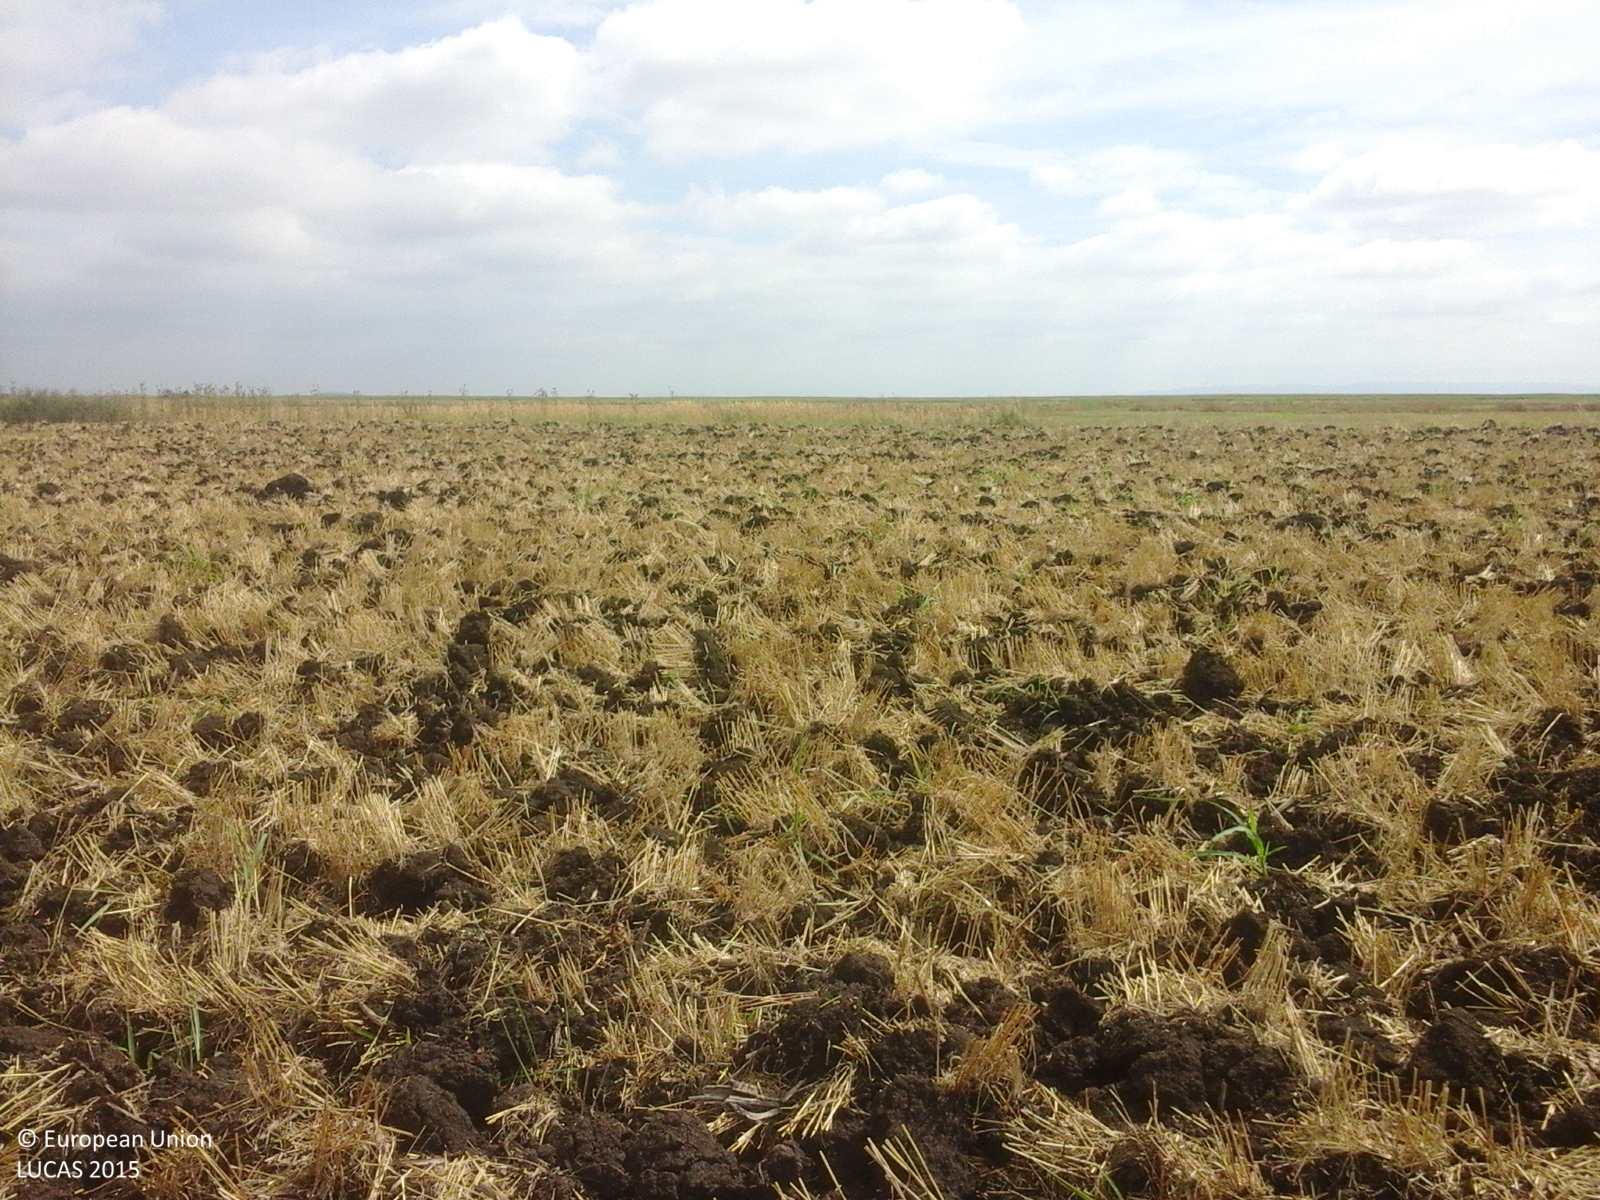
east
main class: Cropland
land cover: Common wheat
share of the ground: 10 - 25 %
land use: Agriculture (excluding fallow land and kitchen gardens)
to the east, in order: Common wheat; Grass margins; Tracks; Grass margins; Ditches and canals; Shruby margins; Tracks; Common wheat; Spontaneously vegetated surfaces; Common wheat
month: August
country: RO
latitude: 45.3175
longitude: 21.2670
